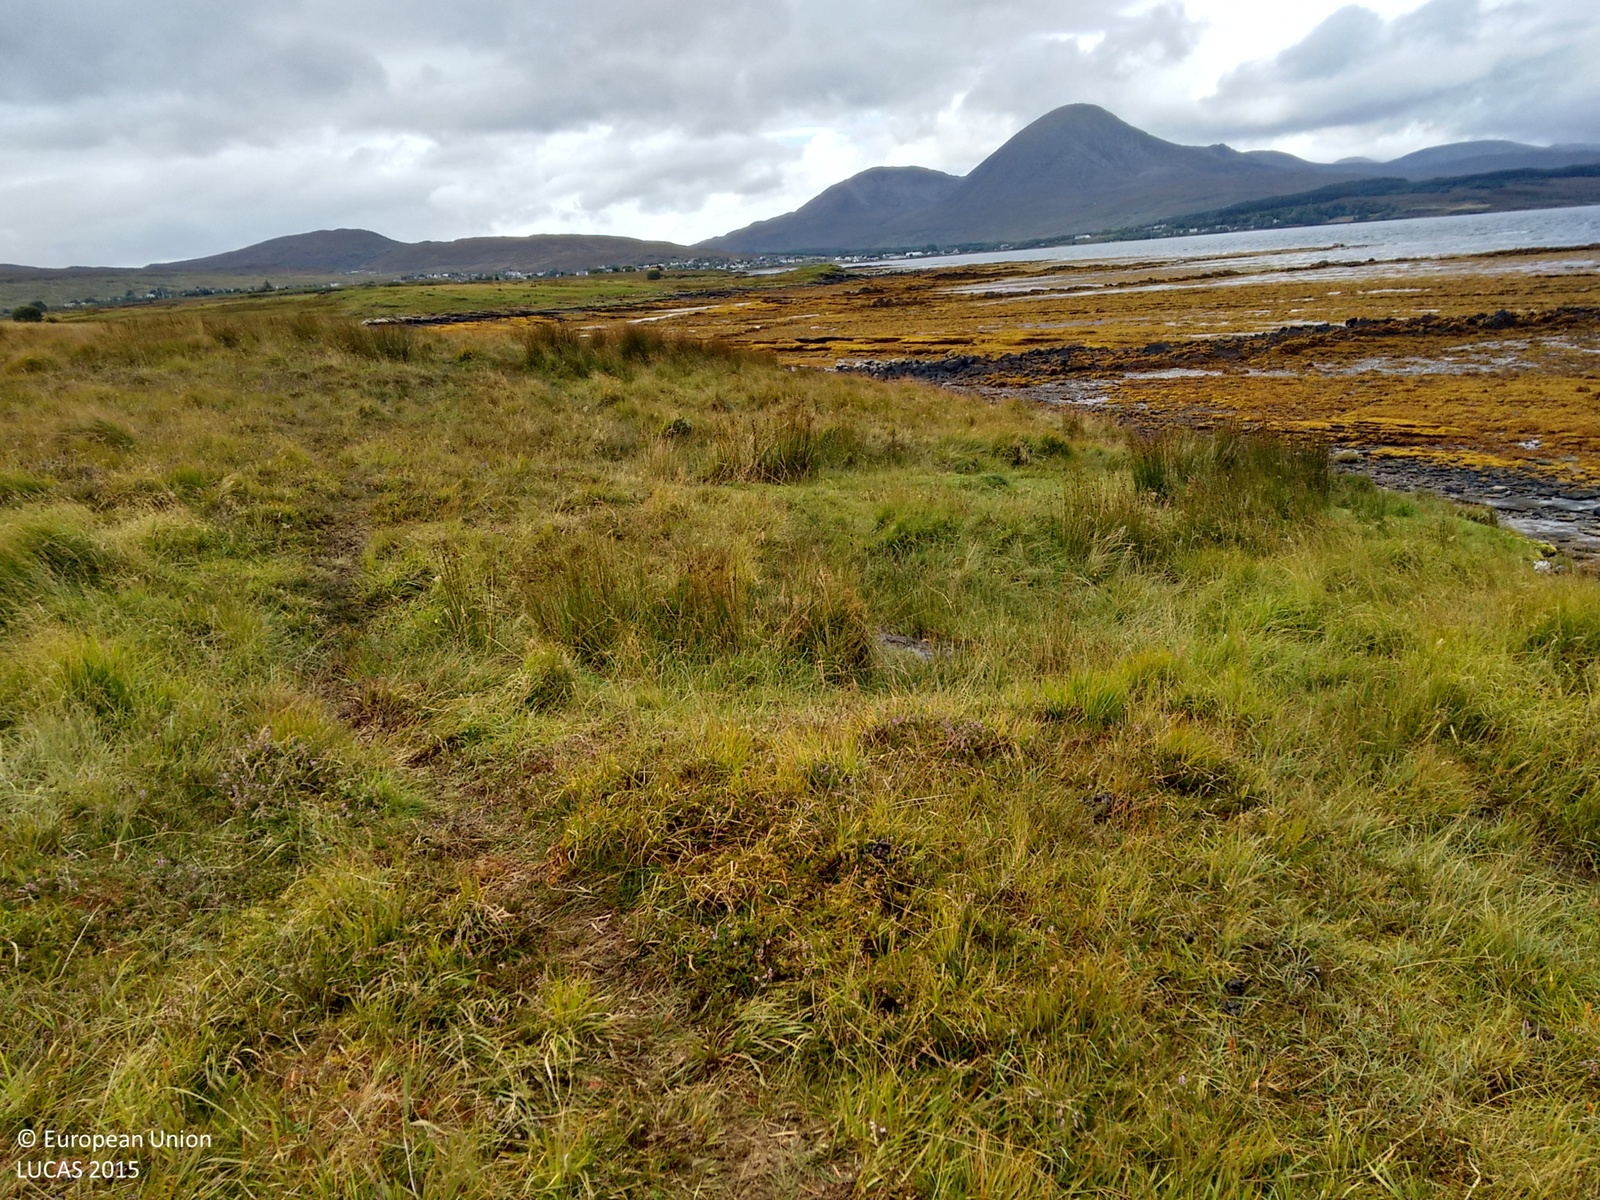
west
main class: Grassland
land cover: Grassland without tree/shrub cover
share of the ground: > 75 %
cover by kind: herbaceous plants 95 %, shrubs 5 %
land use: Agriculture (excluding fallow land and kitchen gardens)
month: September
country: GB
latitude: 57.2507
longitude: -5.8548
